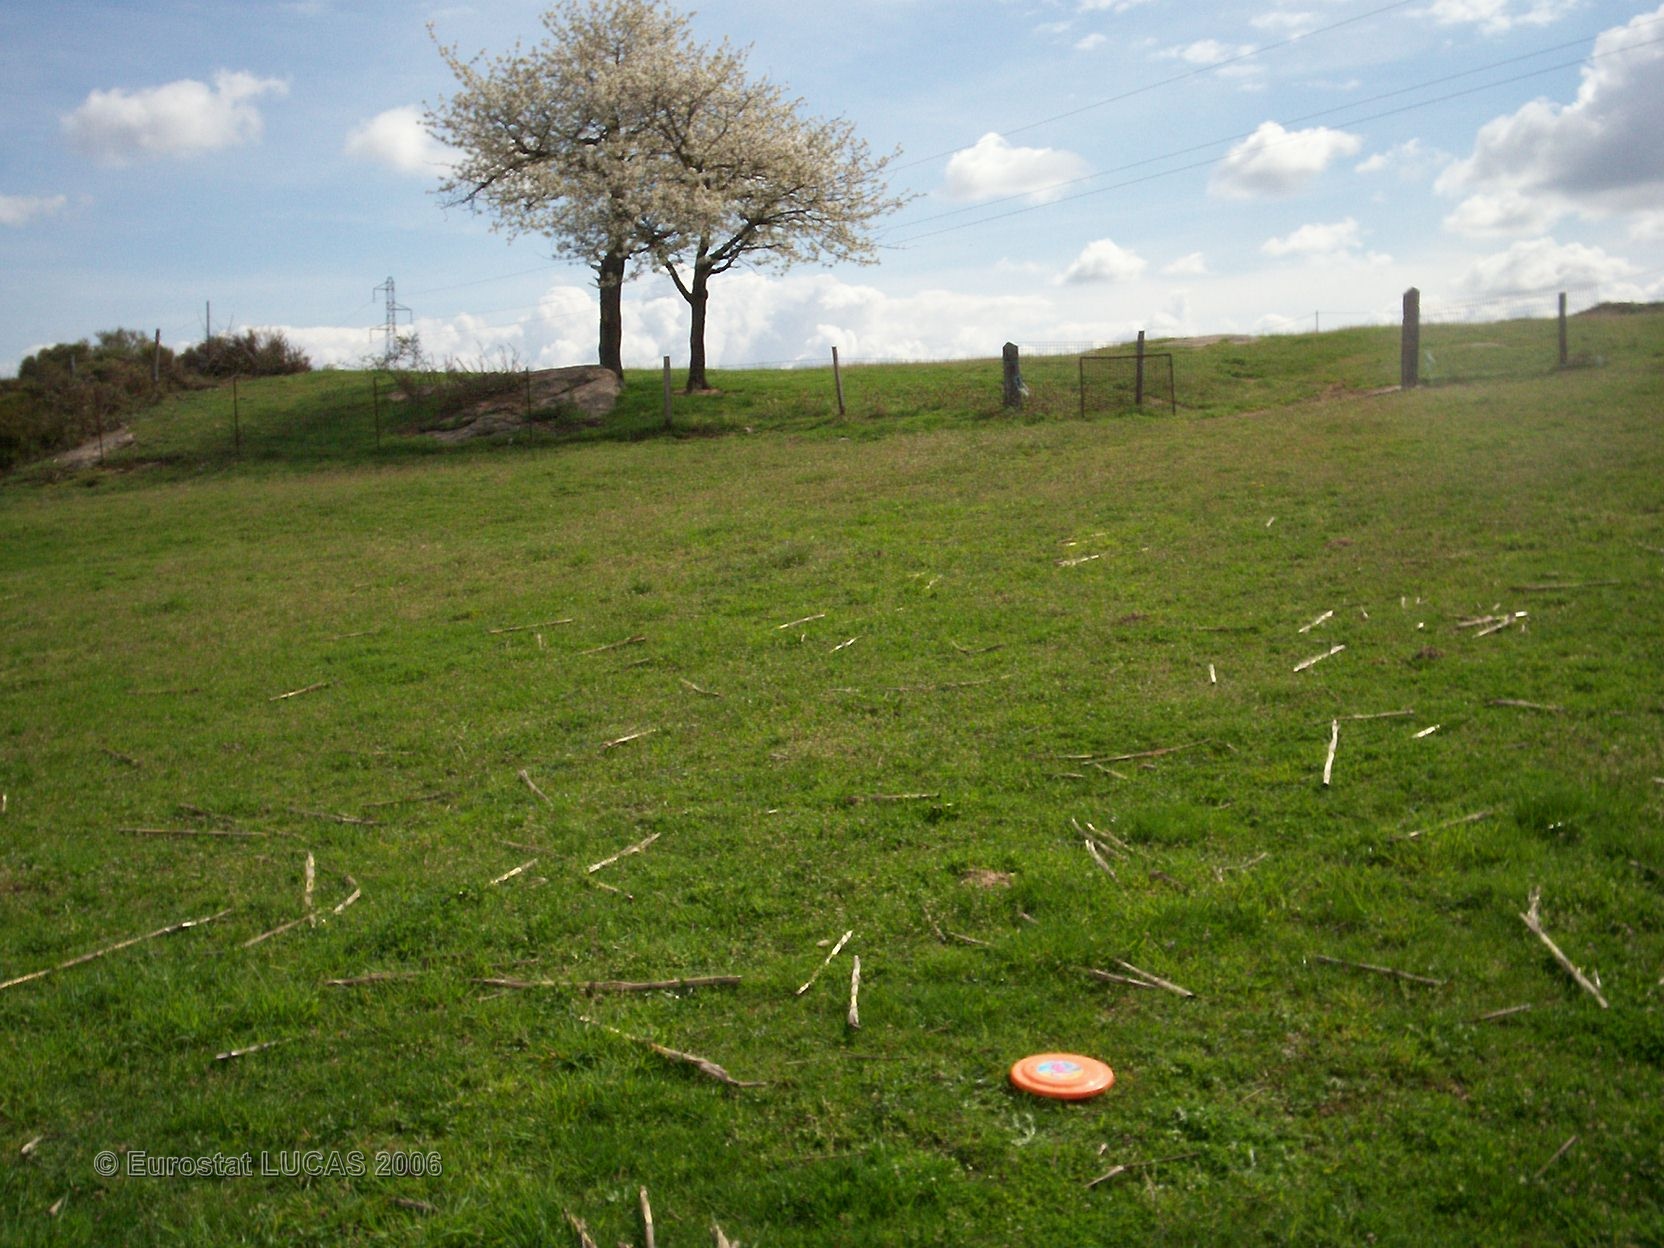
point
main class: Grassland
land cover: Grassland without tree/shrub cover
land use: Agriculture (excluding fallow land and kitchen gardens)
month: April
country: FR
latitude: 45.4719
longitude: 4.2090
